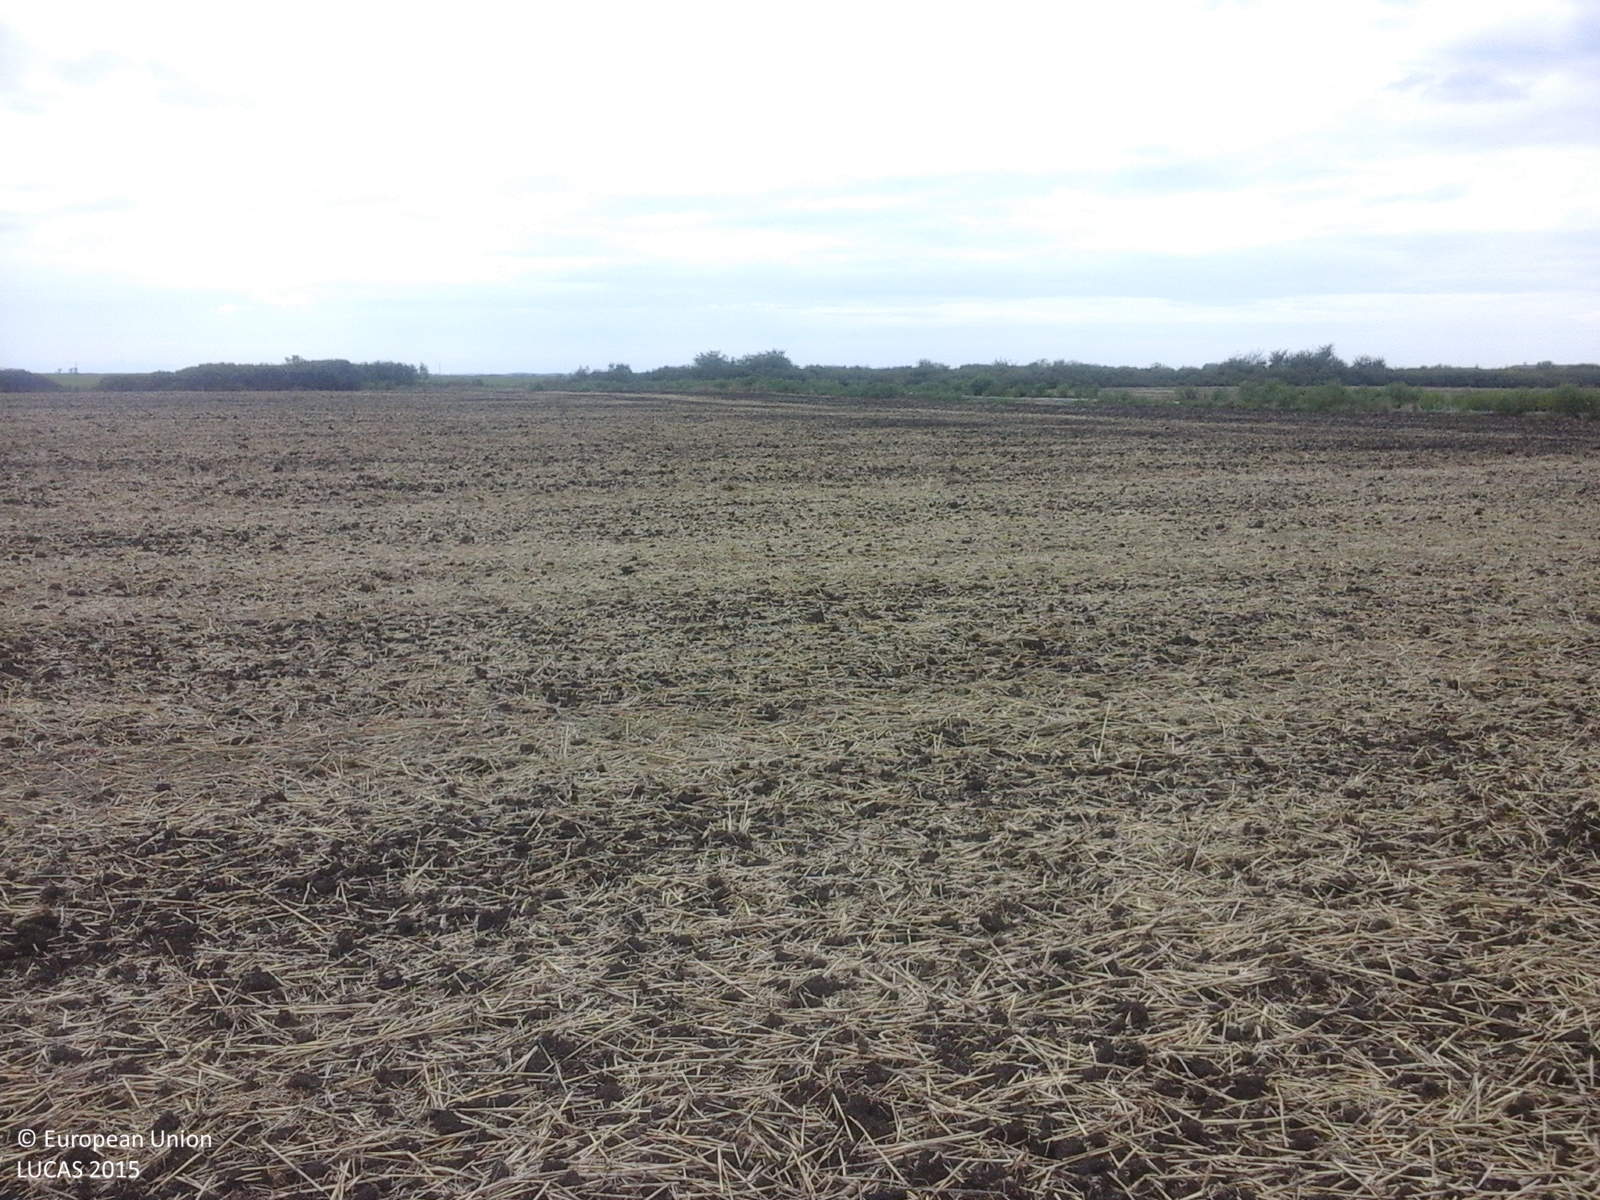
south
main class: Cropland
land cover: Common wheat
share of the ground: 10 - 25 %
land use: Agriculture (excluding fallow land and kitchen gardens)
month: August
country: RO
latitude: 45.5008
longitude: 21.2531
